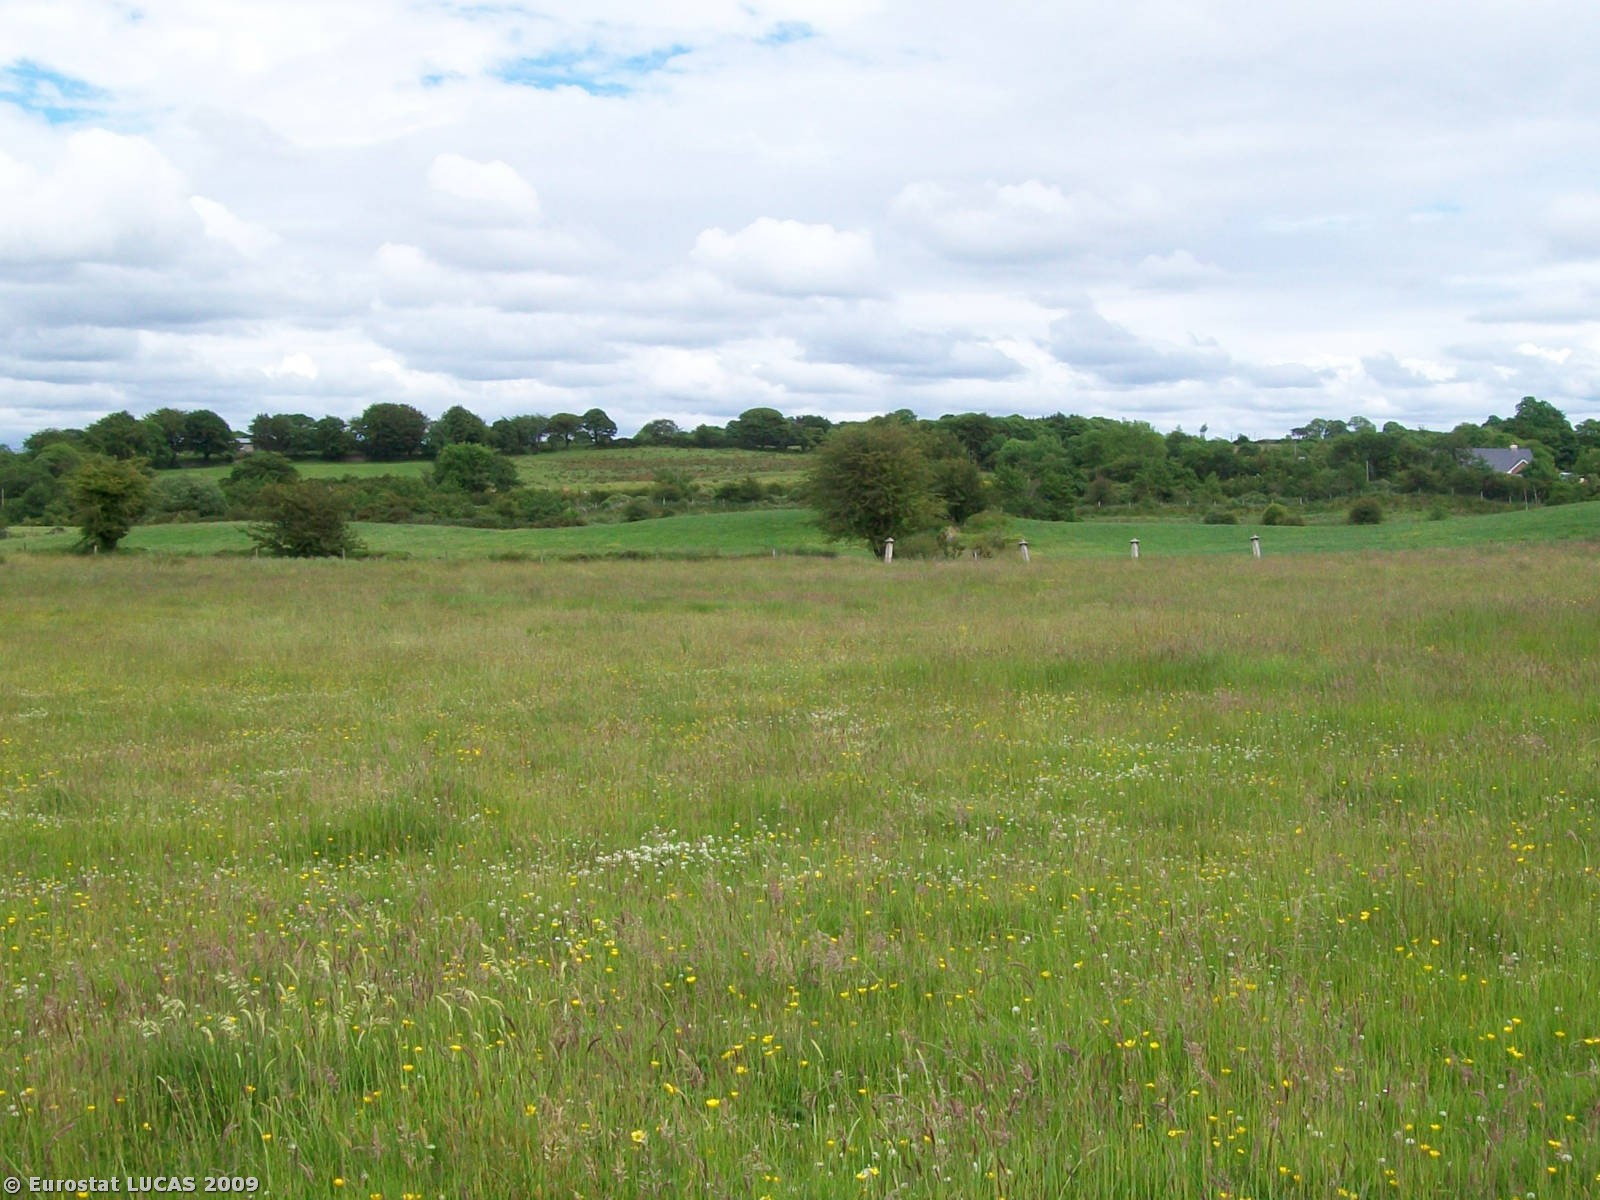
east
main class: Grassland
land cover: Grassland without tree/shrub cover
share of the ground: > 75 %
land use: Agriculture (excluding fallow land and kitchen gardens)
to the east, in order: Grassland without tree/shrub cover; Tracks; Grassland without tree/shrub cover; Fences; Abandoned hedges; Grassland without tree/shrub cover; Fences; Grassland without tree/shrub cover
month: June
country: IE
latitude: 53.7808
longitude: -9.0156
